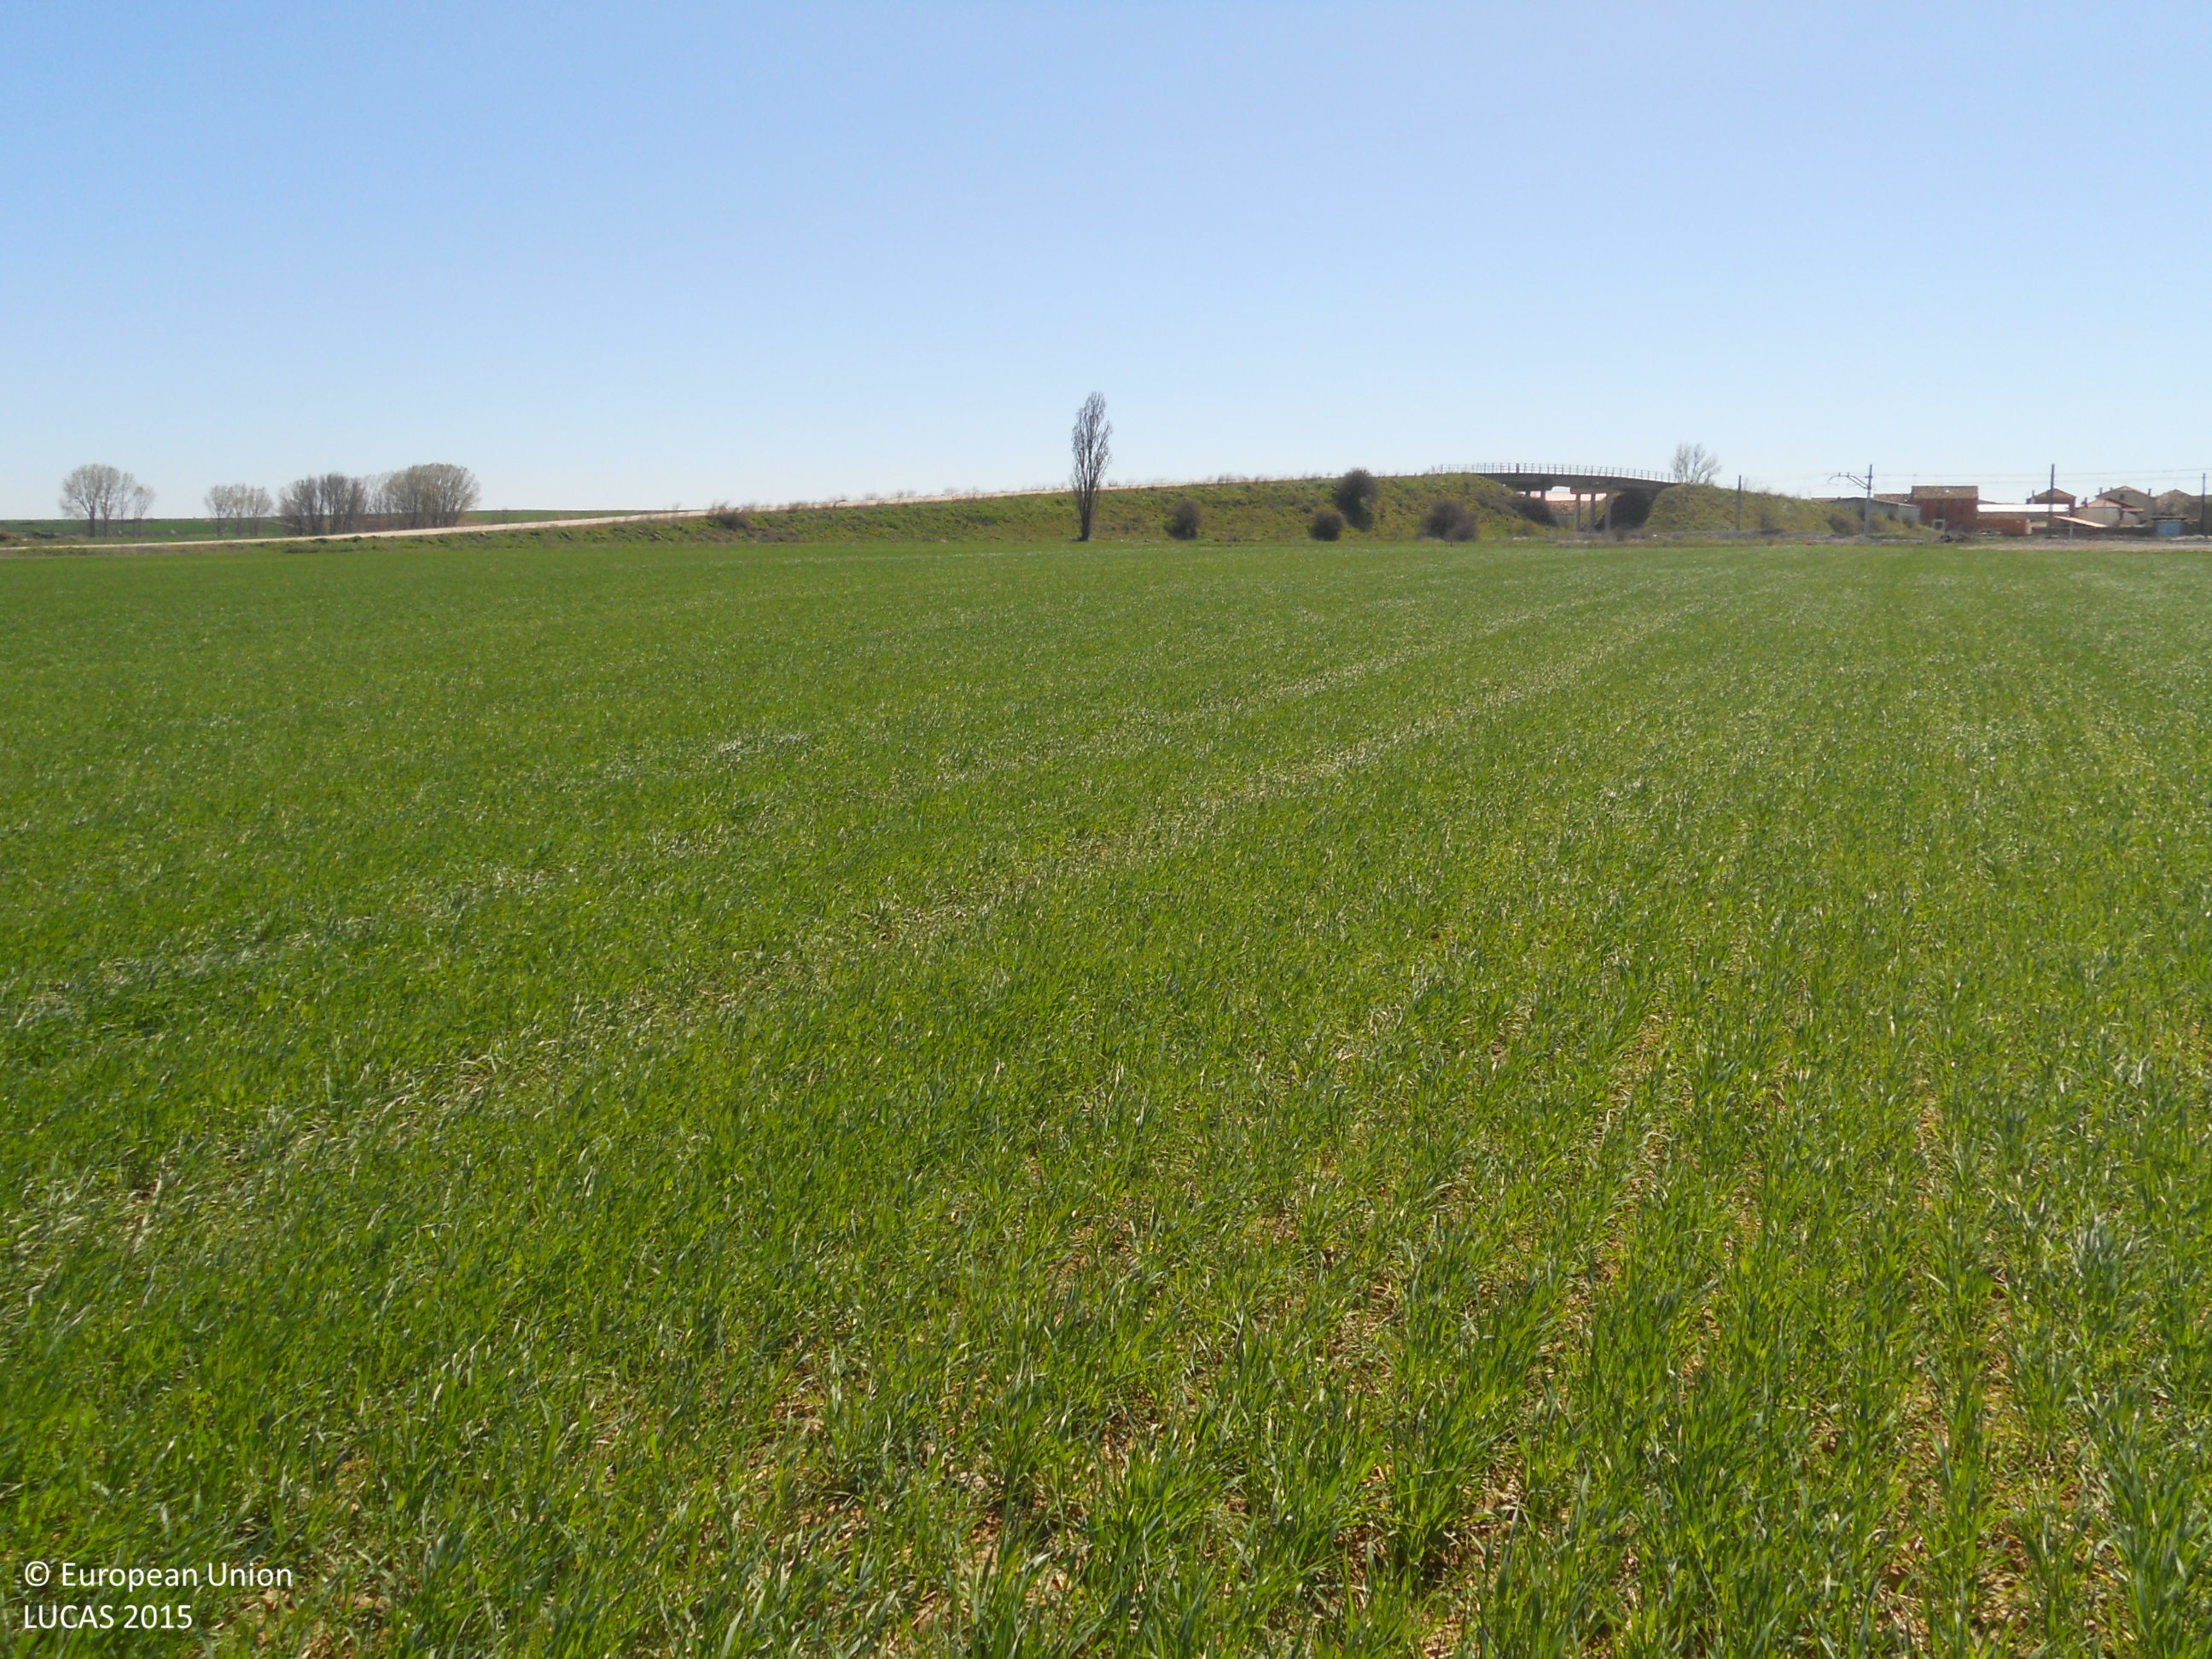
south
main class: Cropland
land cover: Barley
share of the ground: > 75 %
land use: Agriculture (excluding fallow land and kitchen gardens)
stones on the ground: < 10 %
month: April
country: ES
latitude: 42.3571
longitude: -4.3612
